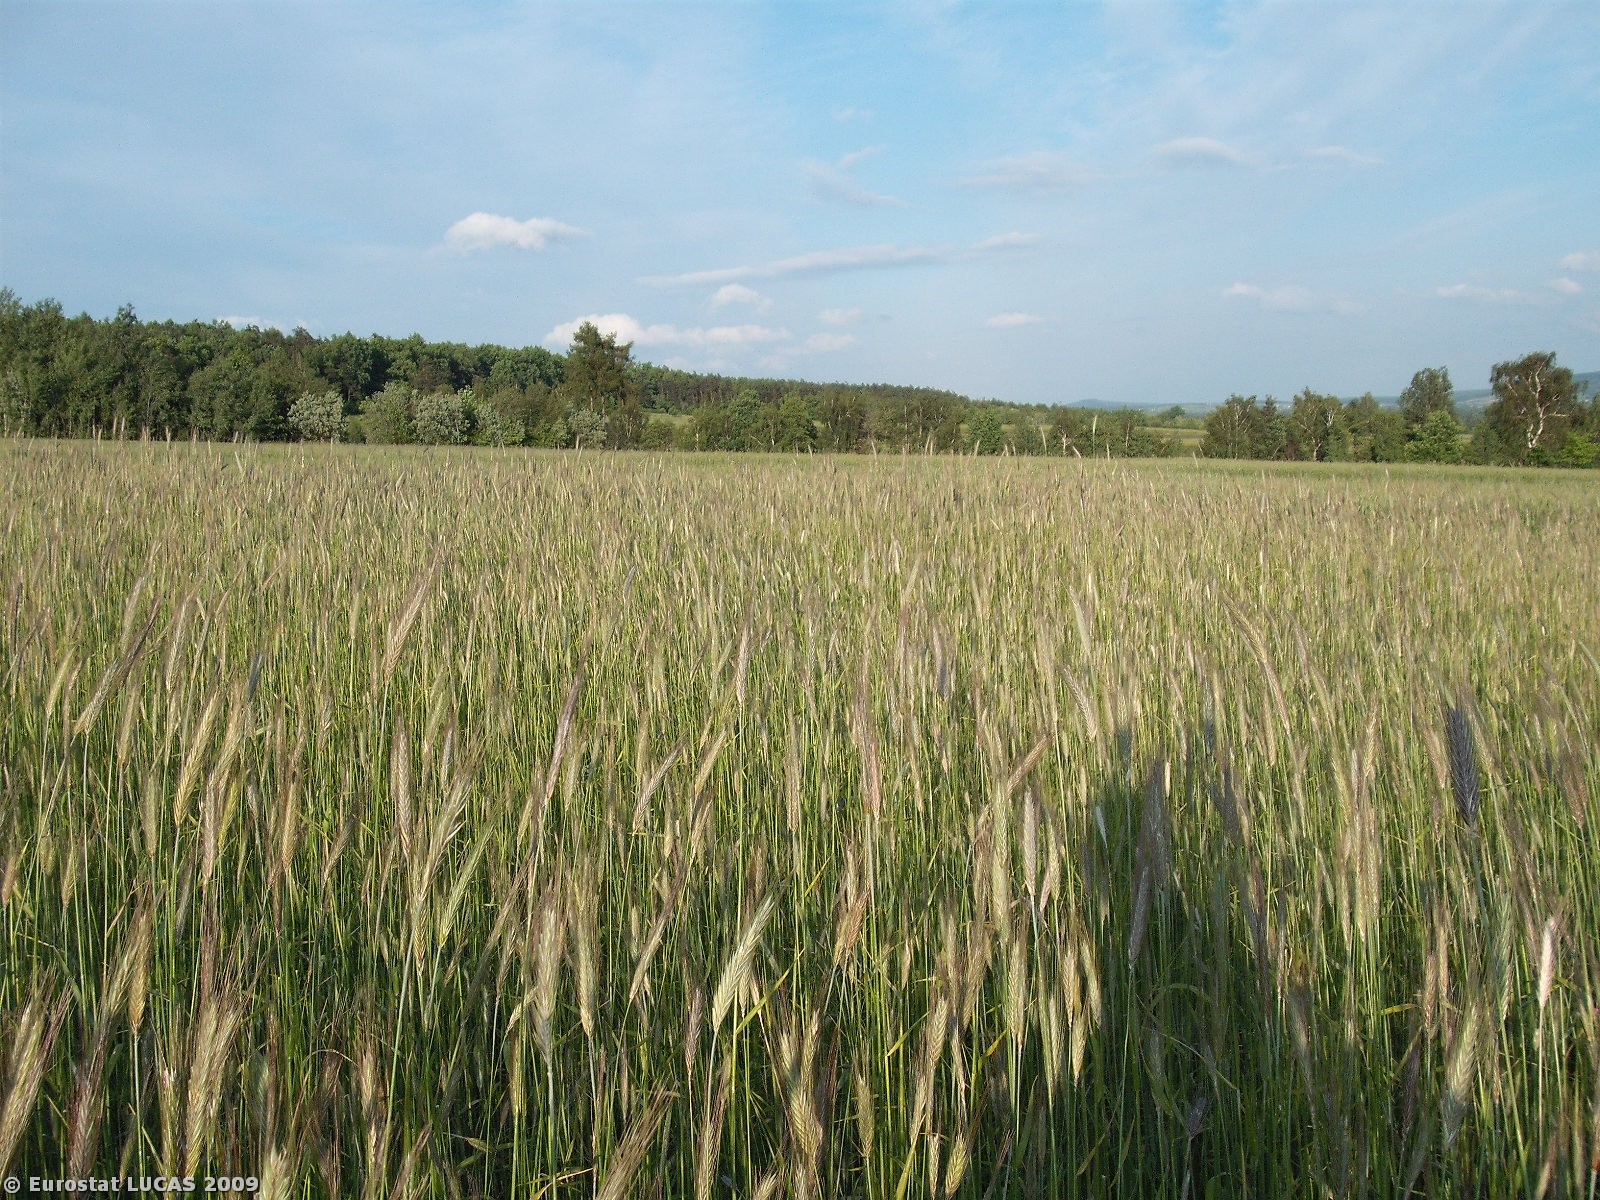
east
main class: Cropland
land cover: Rye
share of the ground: > 75 %
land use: Agriculture (excluding fallow land and kitchen gardens)
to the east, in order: Rye; Grass margins; Barley; Grass margins; Strawberries; Grass margins; Common wheat; Grass margins; Triticale; Grass margins; Barley; Grass margins; Triticale; Grass margins; Triticale; Tracks; Rye; Grass margins; Triticale; Broadleaved woodland; Grassland without tree/shrub cover; Strawberries; Grass margins; Barley; Tracks; Barley; Grass margins
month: June
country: PL
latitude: 50.8771
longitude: 20.8867
